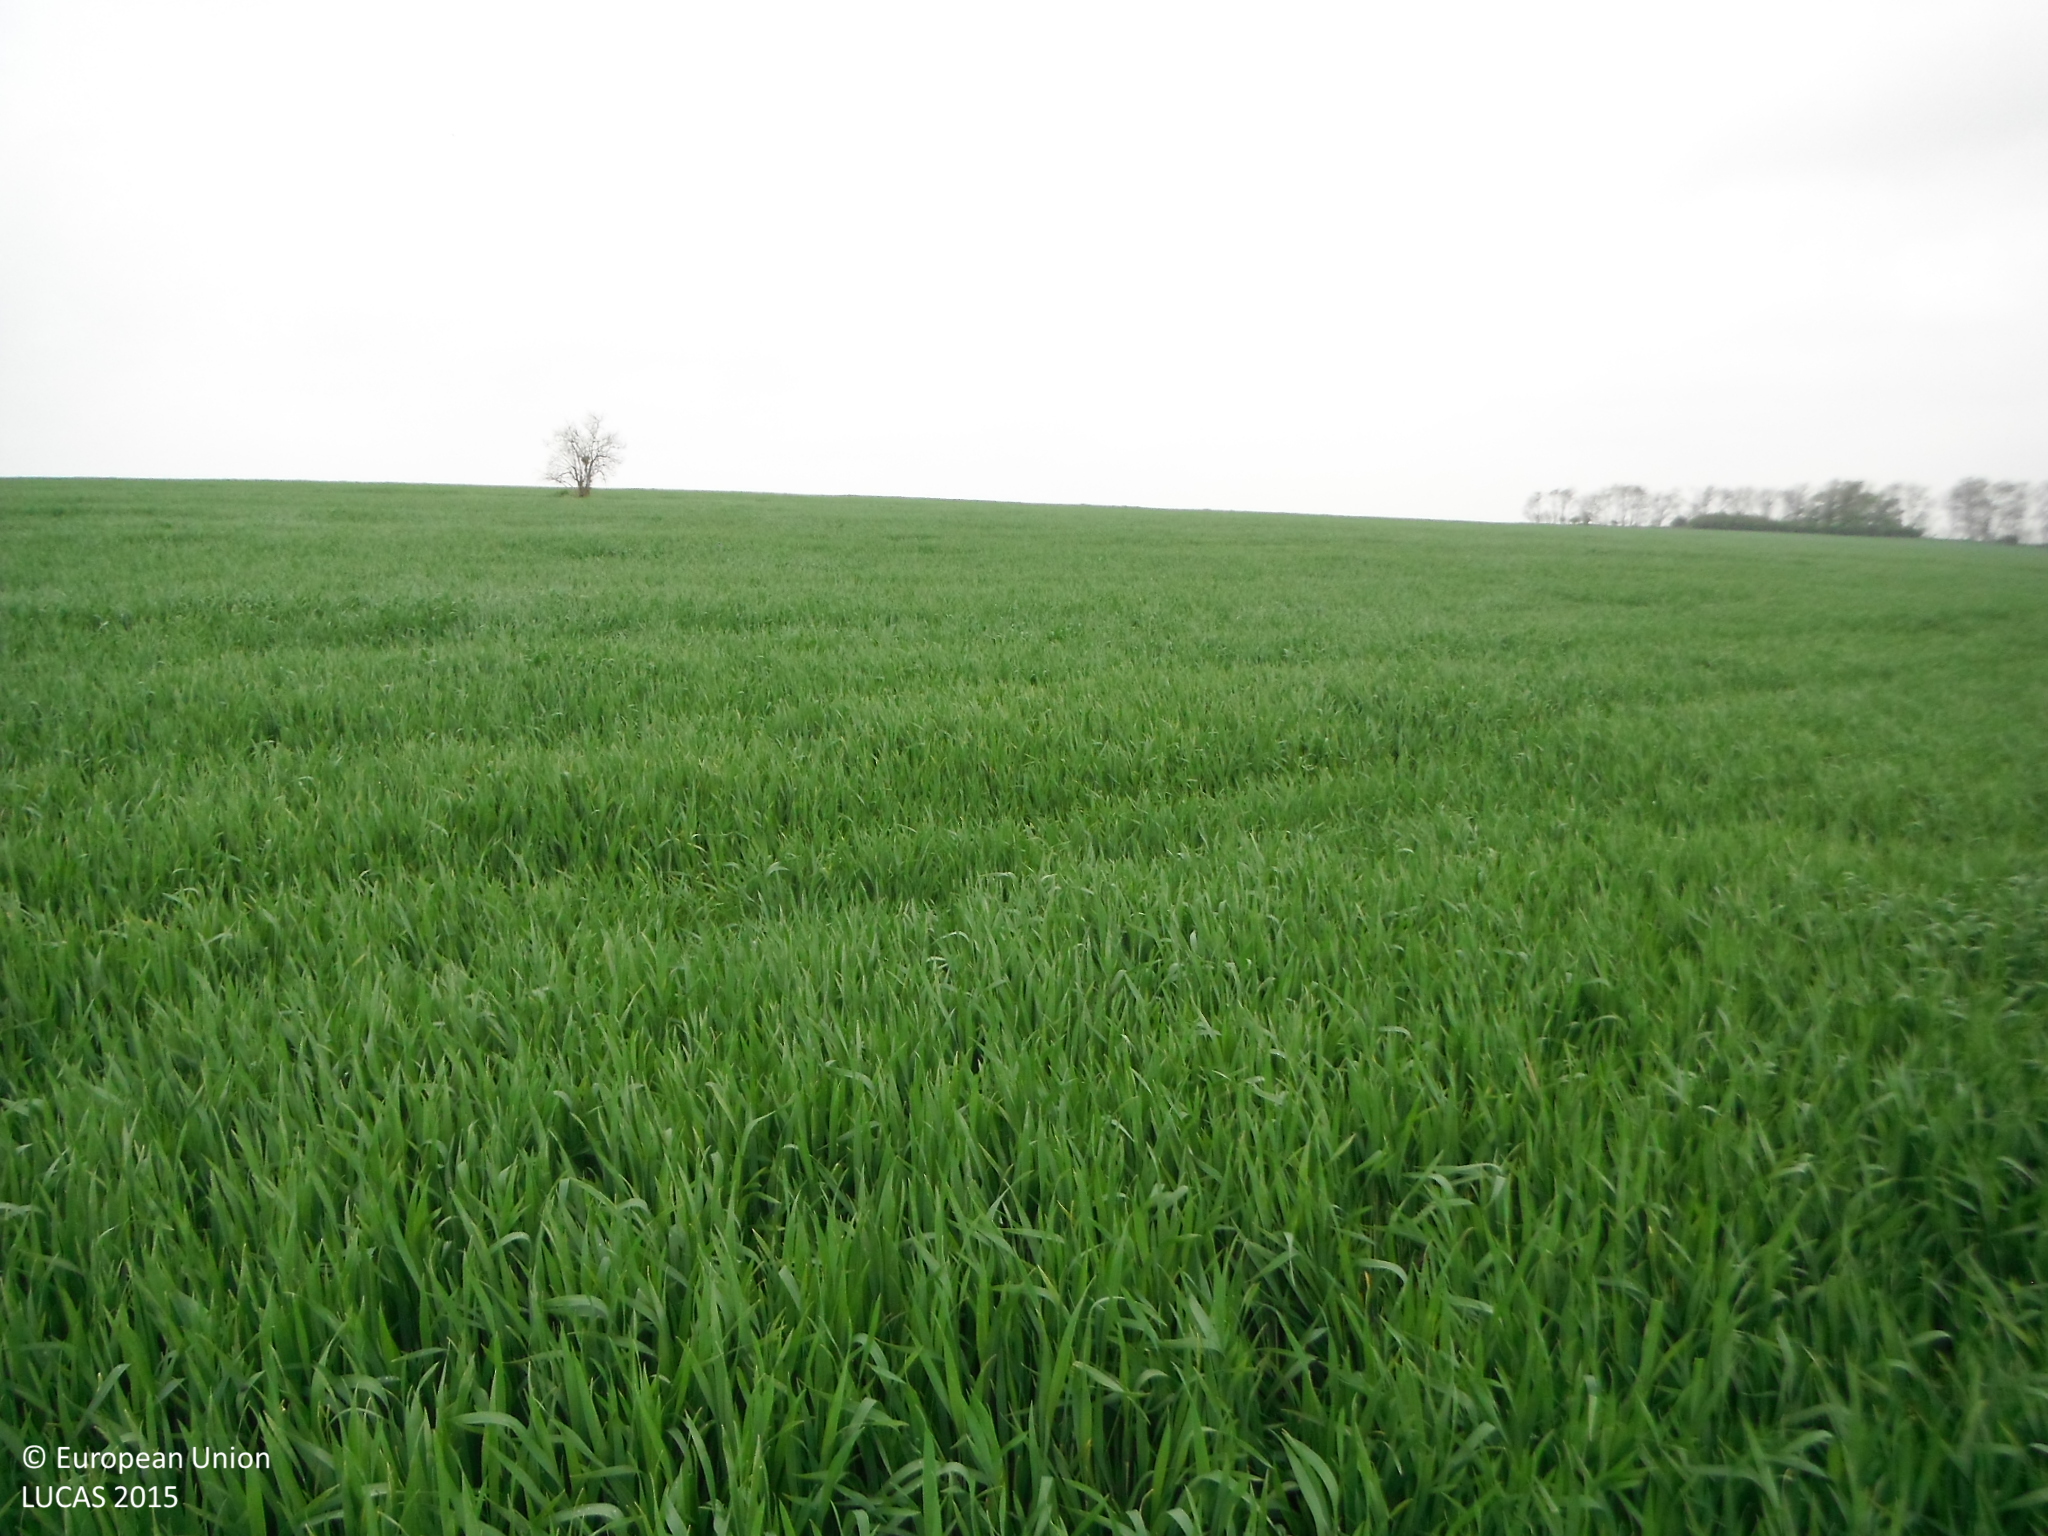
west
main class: Cropland
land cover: Common wheat
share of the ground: > 75 %
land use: Agriculture (excluding fallow land and kitchen gardens)
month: May
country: SK
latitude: 48.3473
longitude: 18.0148
